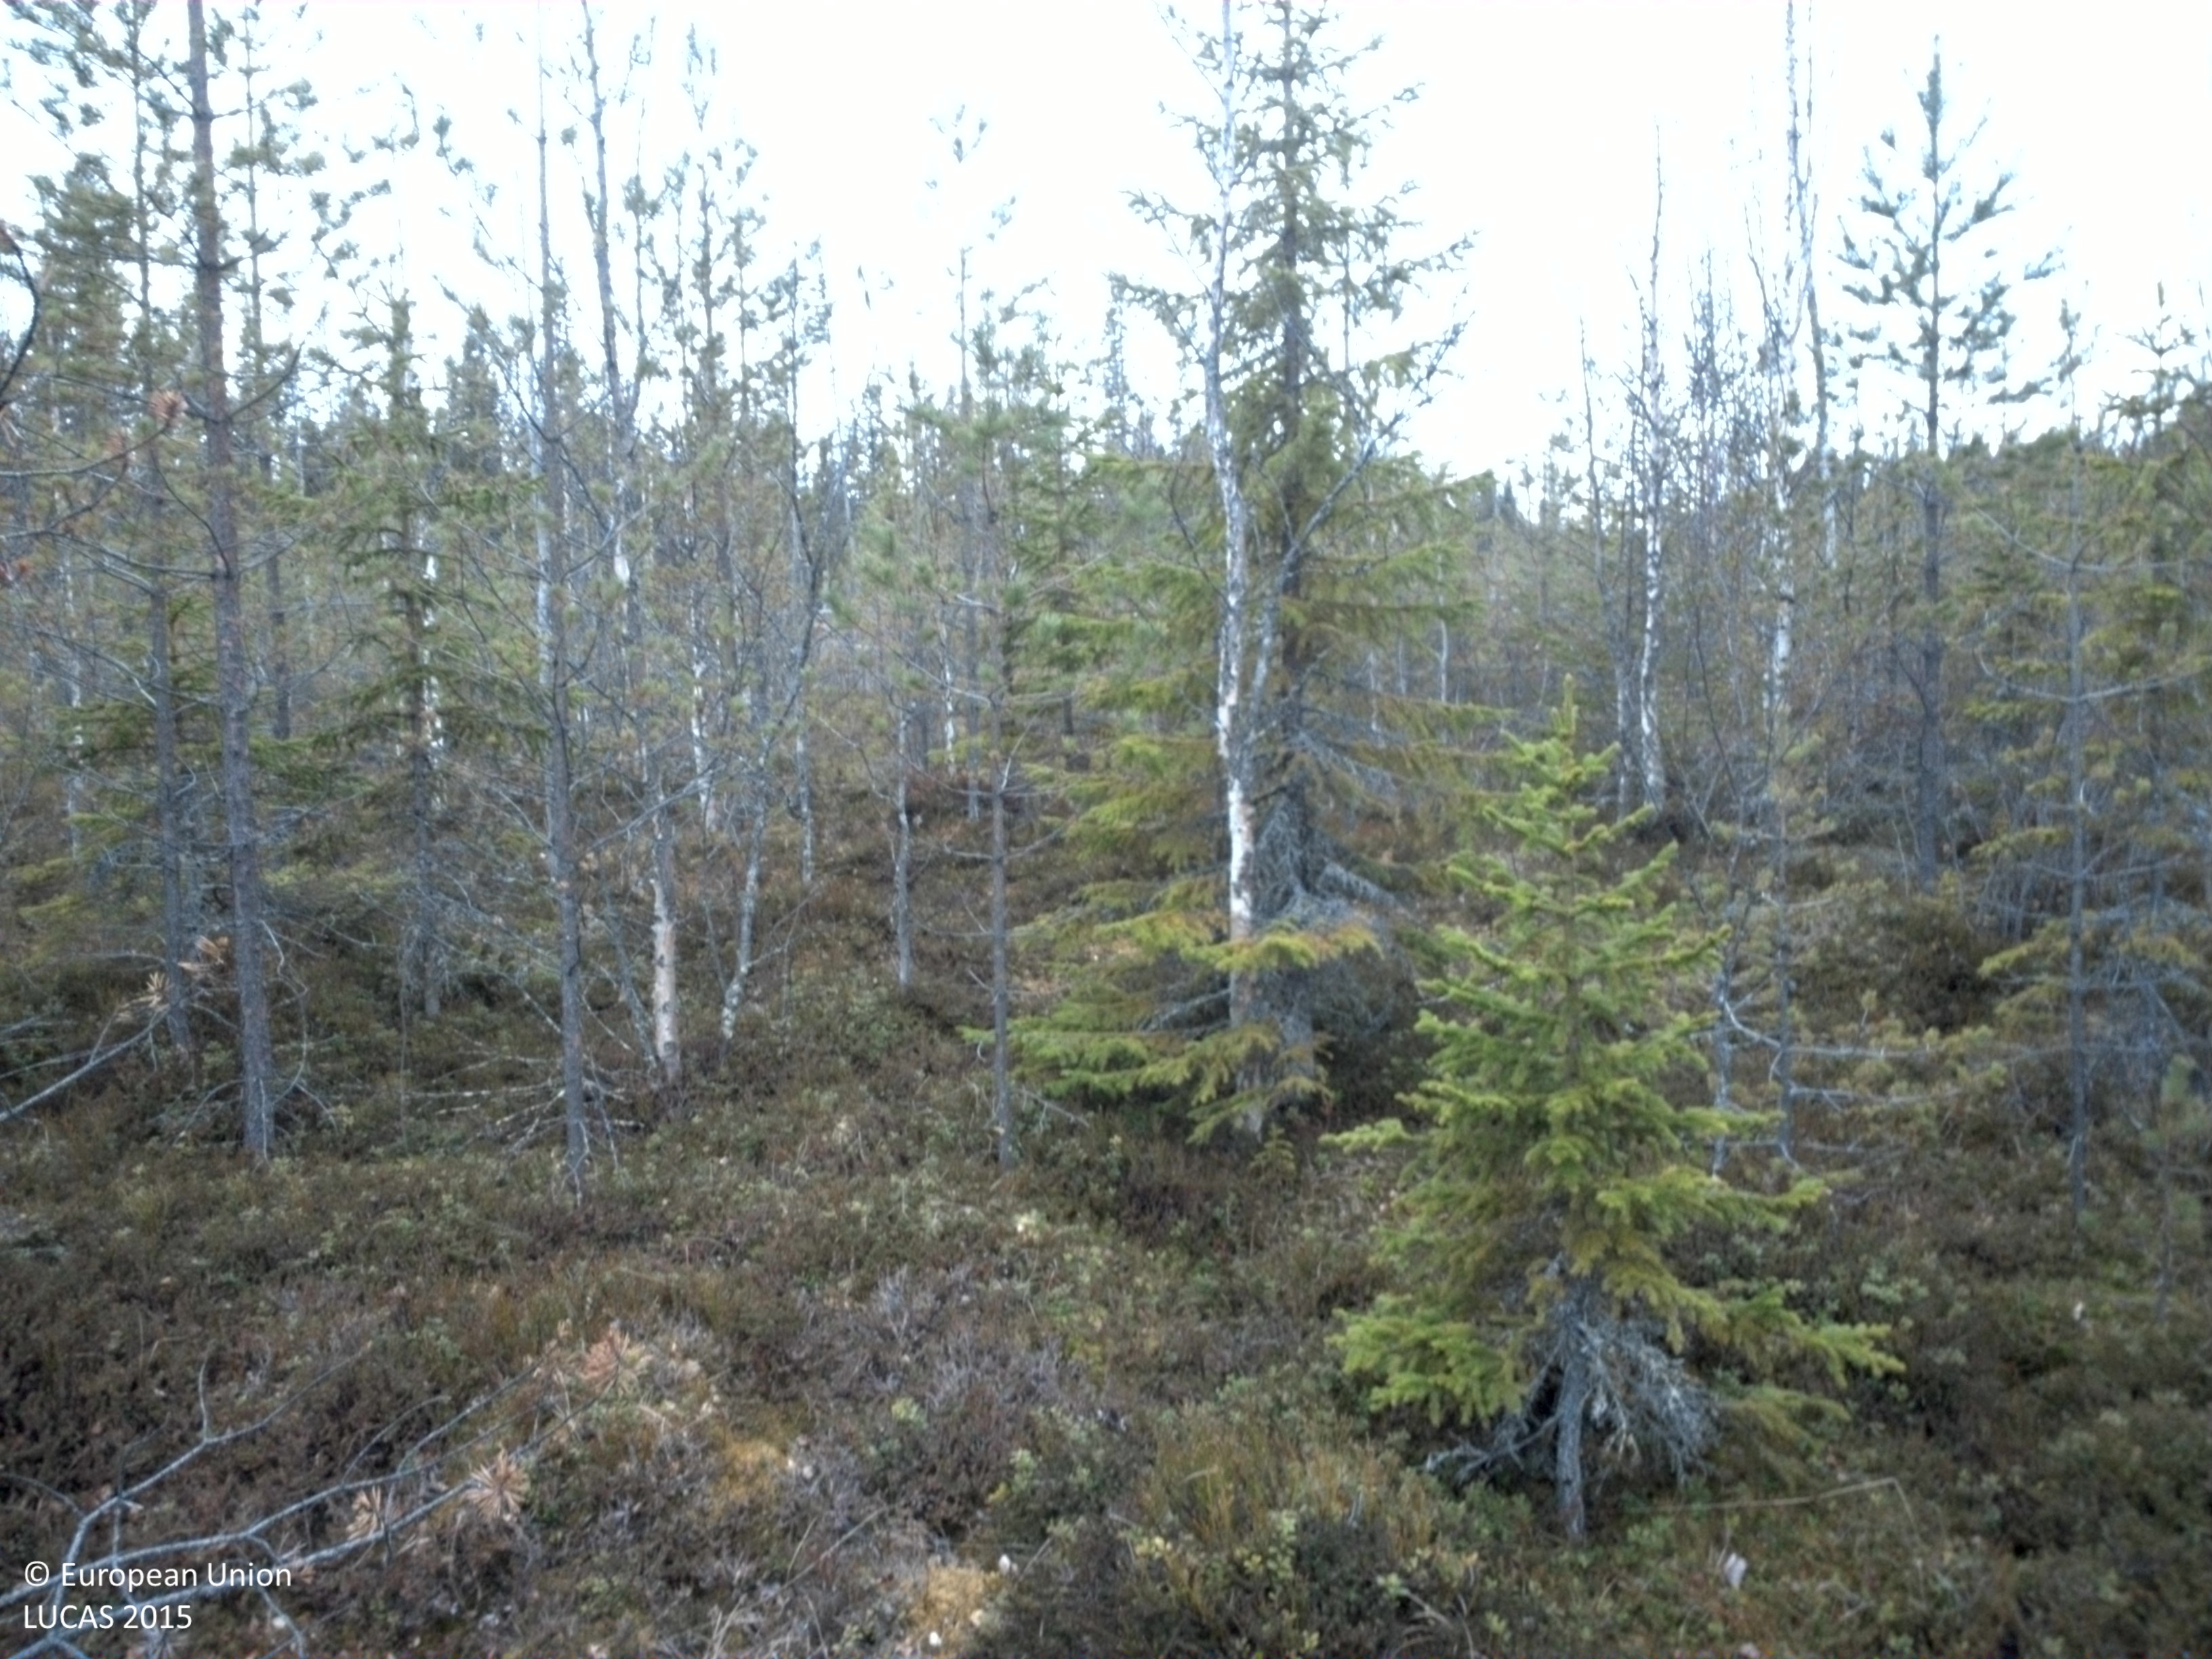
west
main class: Woodland
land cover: Pine dominated coniferous woodland
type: boreal forest
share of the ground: > 75 %
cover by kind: coniferous forest trees 85 %, shrubs 10 %, broadleaved forest trees 5 %
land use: Forestry
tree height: > 5 m
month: May
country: SE
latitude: 62.5830
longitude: 14.4393
